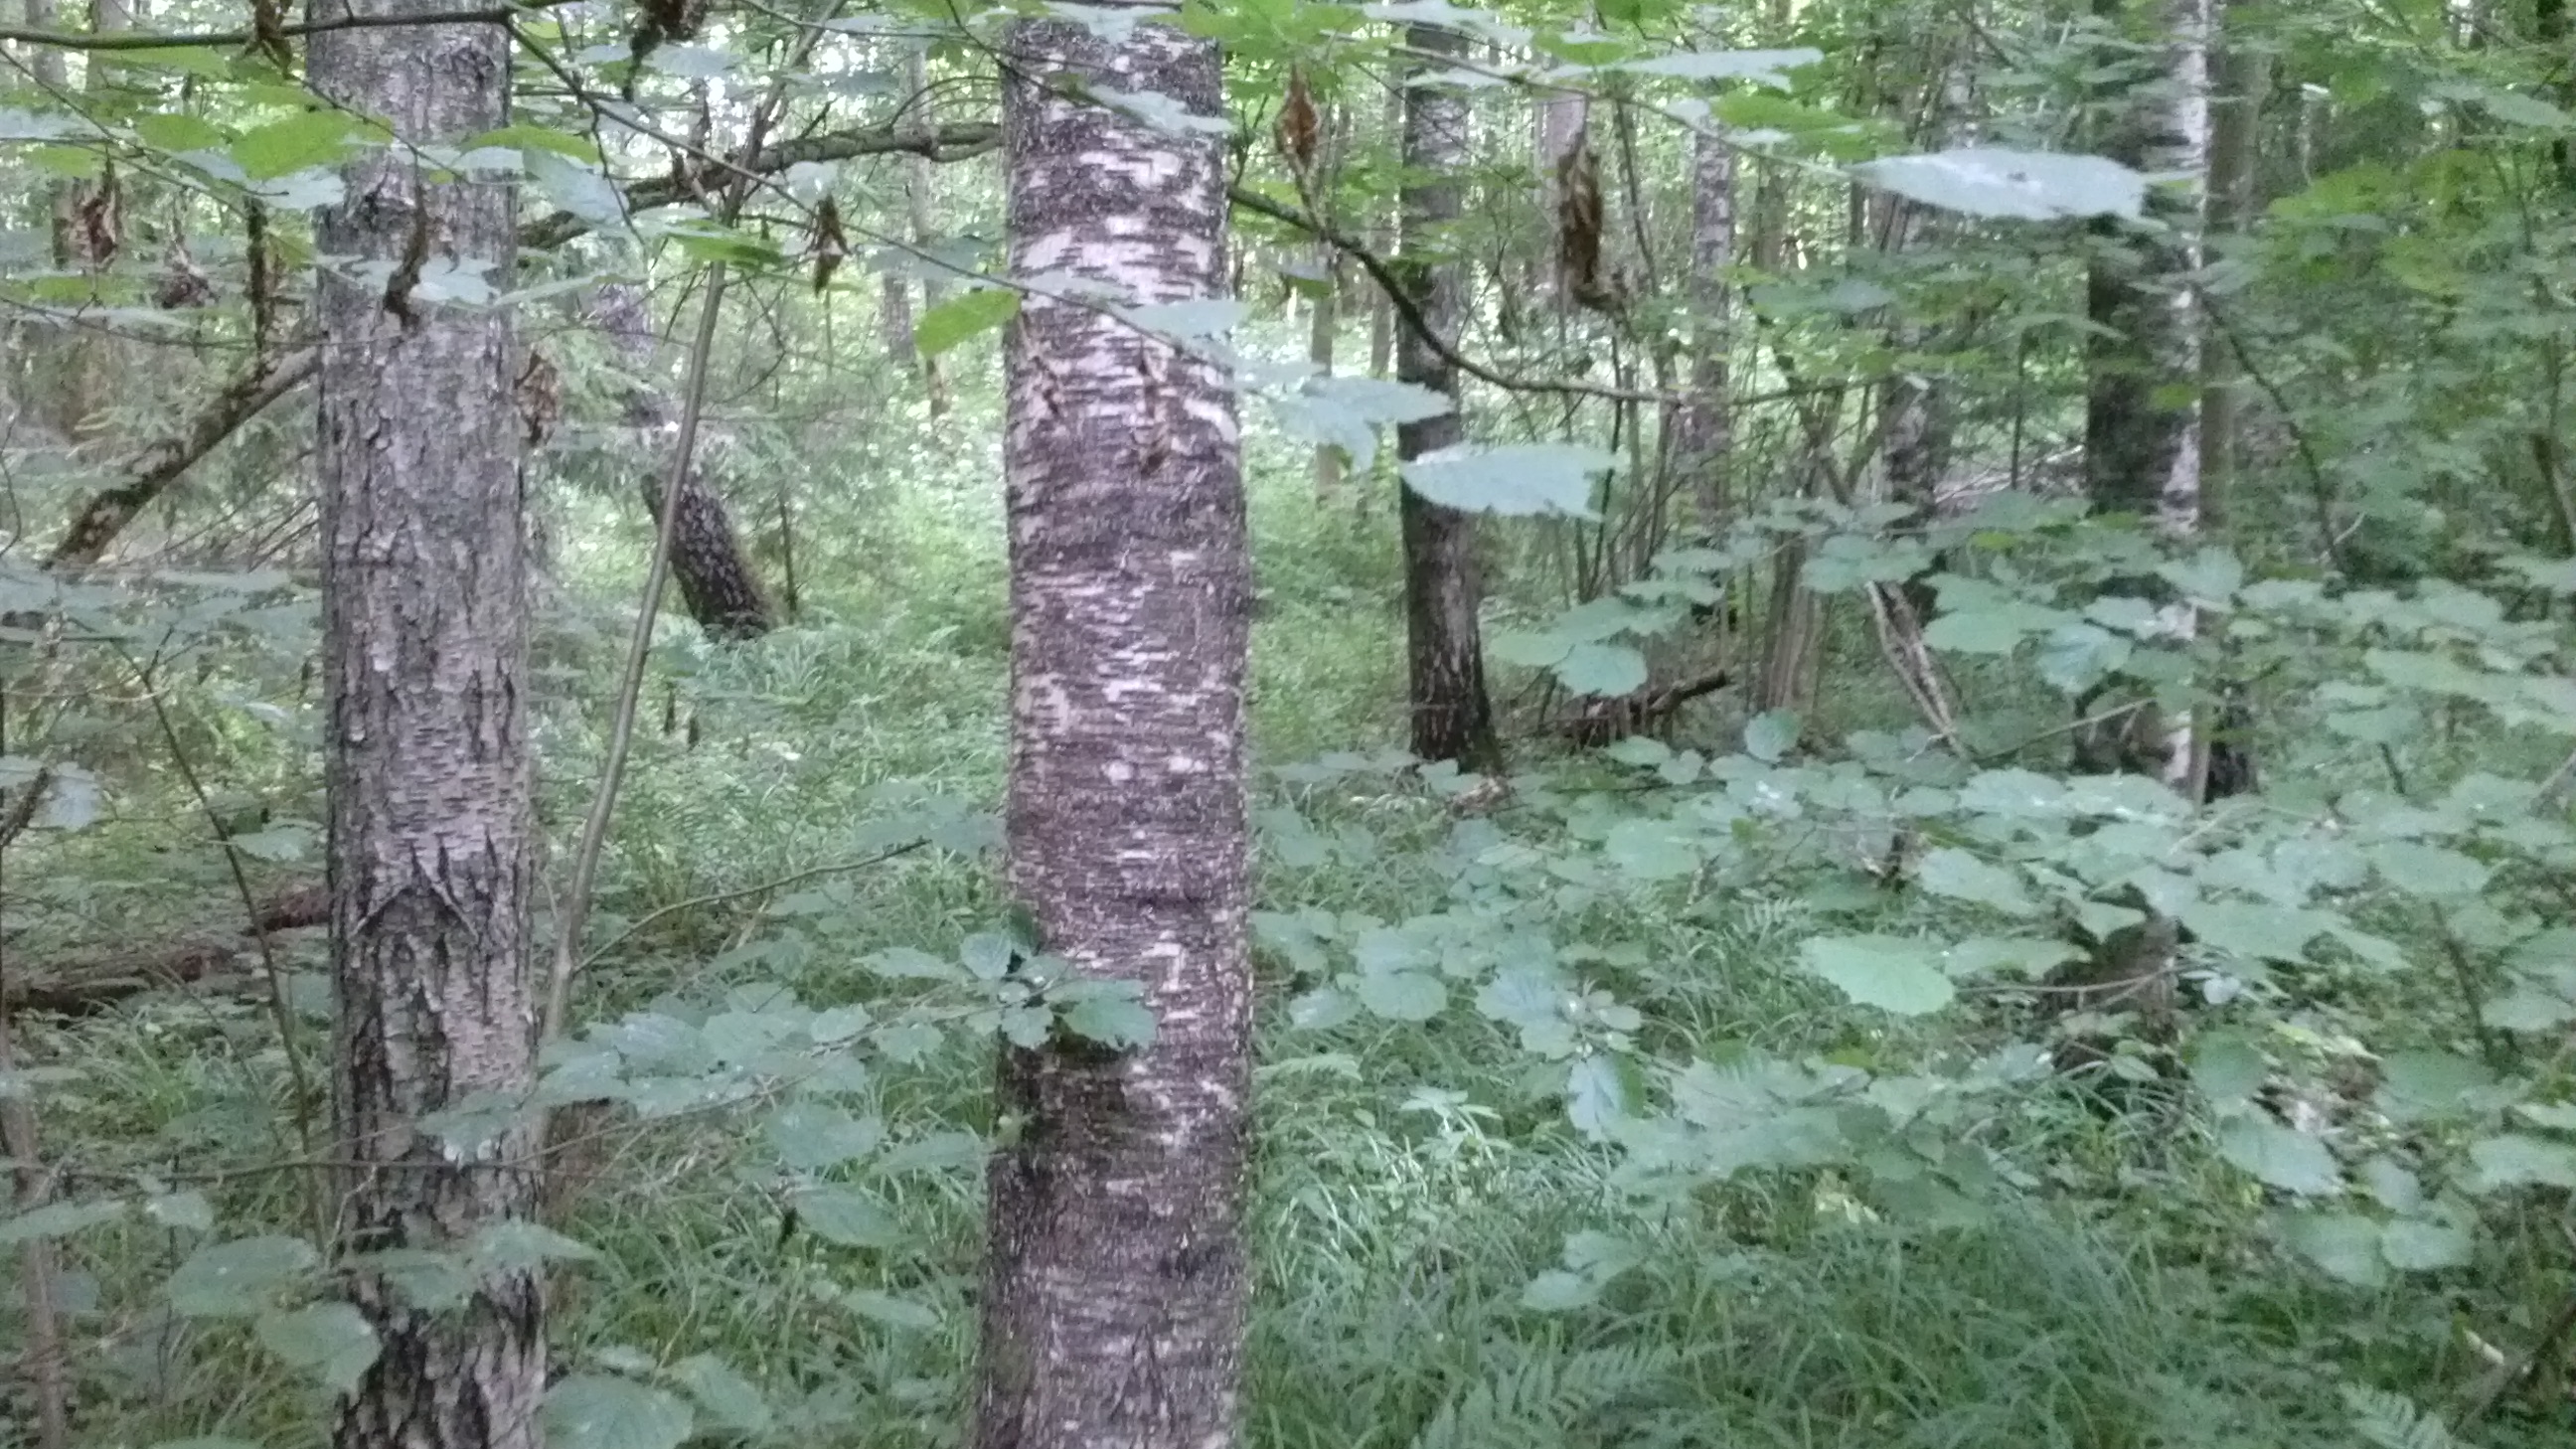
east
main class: Woodland
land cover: Spruce dominated mixed woodland
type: hemiboreal forest and nemoral coniferous forest and mixed broadleaved-coniferous forest
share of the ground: > 75 %
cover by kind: coniferous forest trees 55 %, broadleaved forest trees 30 %, herbaceous plants 10 %, shrubs 5 %
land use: Forestry
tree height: > 5 m
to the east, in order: Spruce dominated mixed woodland; Spruce dominated coniferous woodland; Broadleaved woodland; Spontaneously vegetated surfaces; Broadleaved woodland
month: June
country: LV
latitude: 56.5784
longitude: 27.7524
